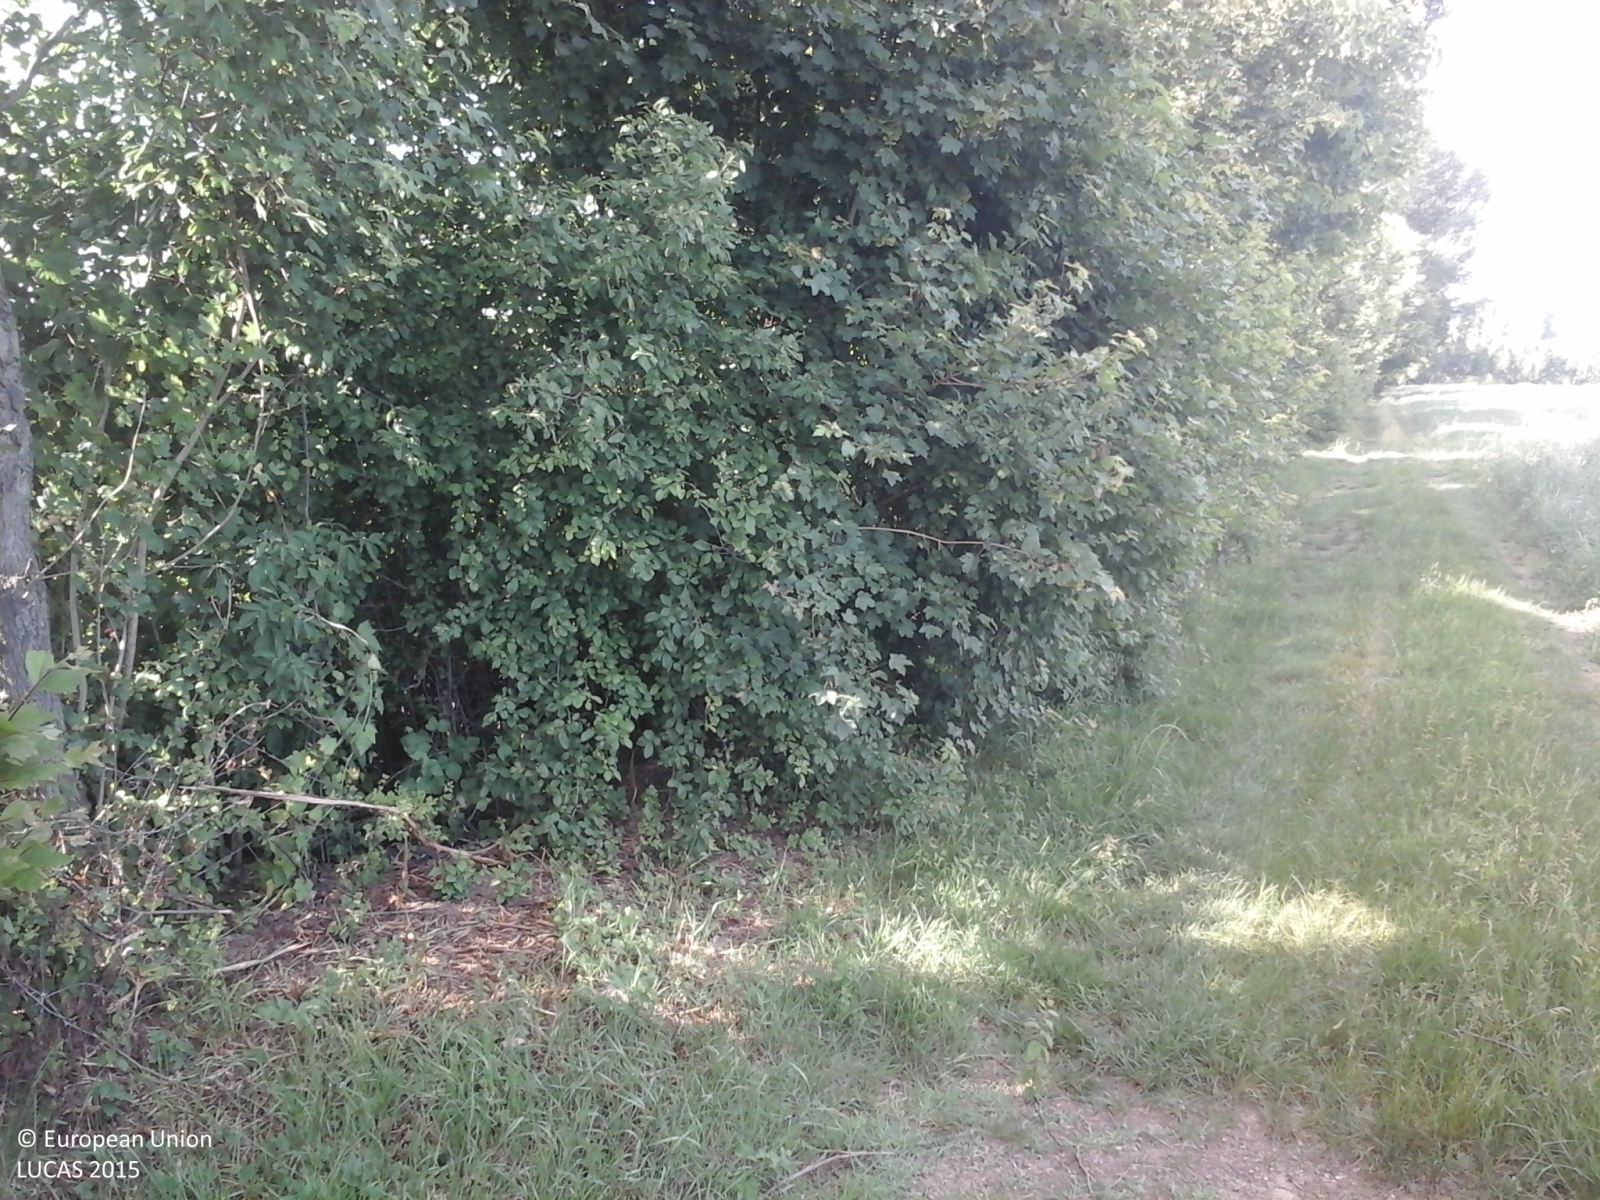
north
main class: Cropland
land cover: Lucerne
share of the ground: > 75 %
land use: Agriculture (excluding fallow land and kitchen gardens)
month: May
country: IT
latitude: 45.1048
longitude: 10.7991
